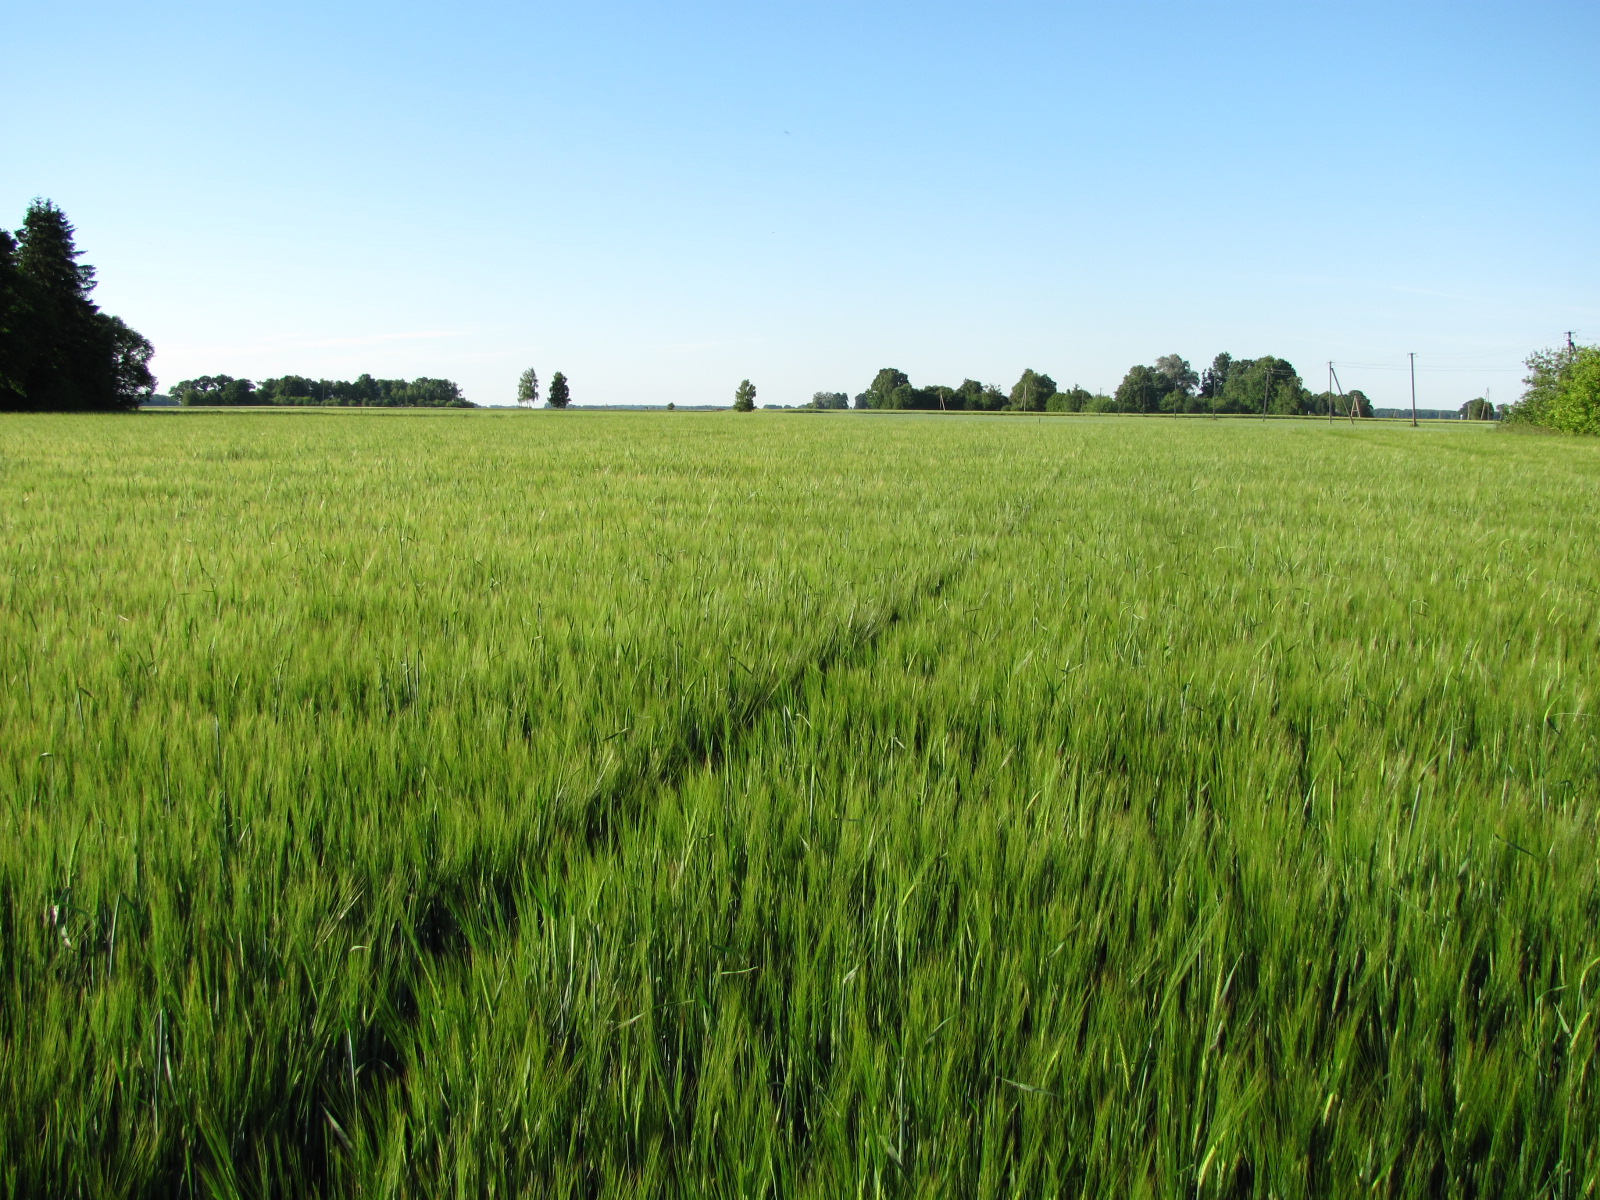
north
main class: Cropland
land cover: Barley
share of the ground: > 75 %
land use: Agriculture (excluding fallow land and kitchen gardens)
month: July
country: LV
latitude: 56.4192
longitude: 23.8453
